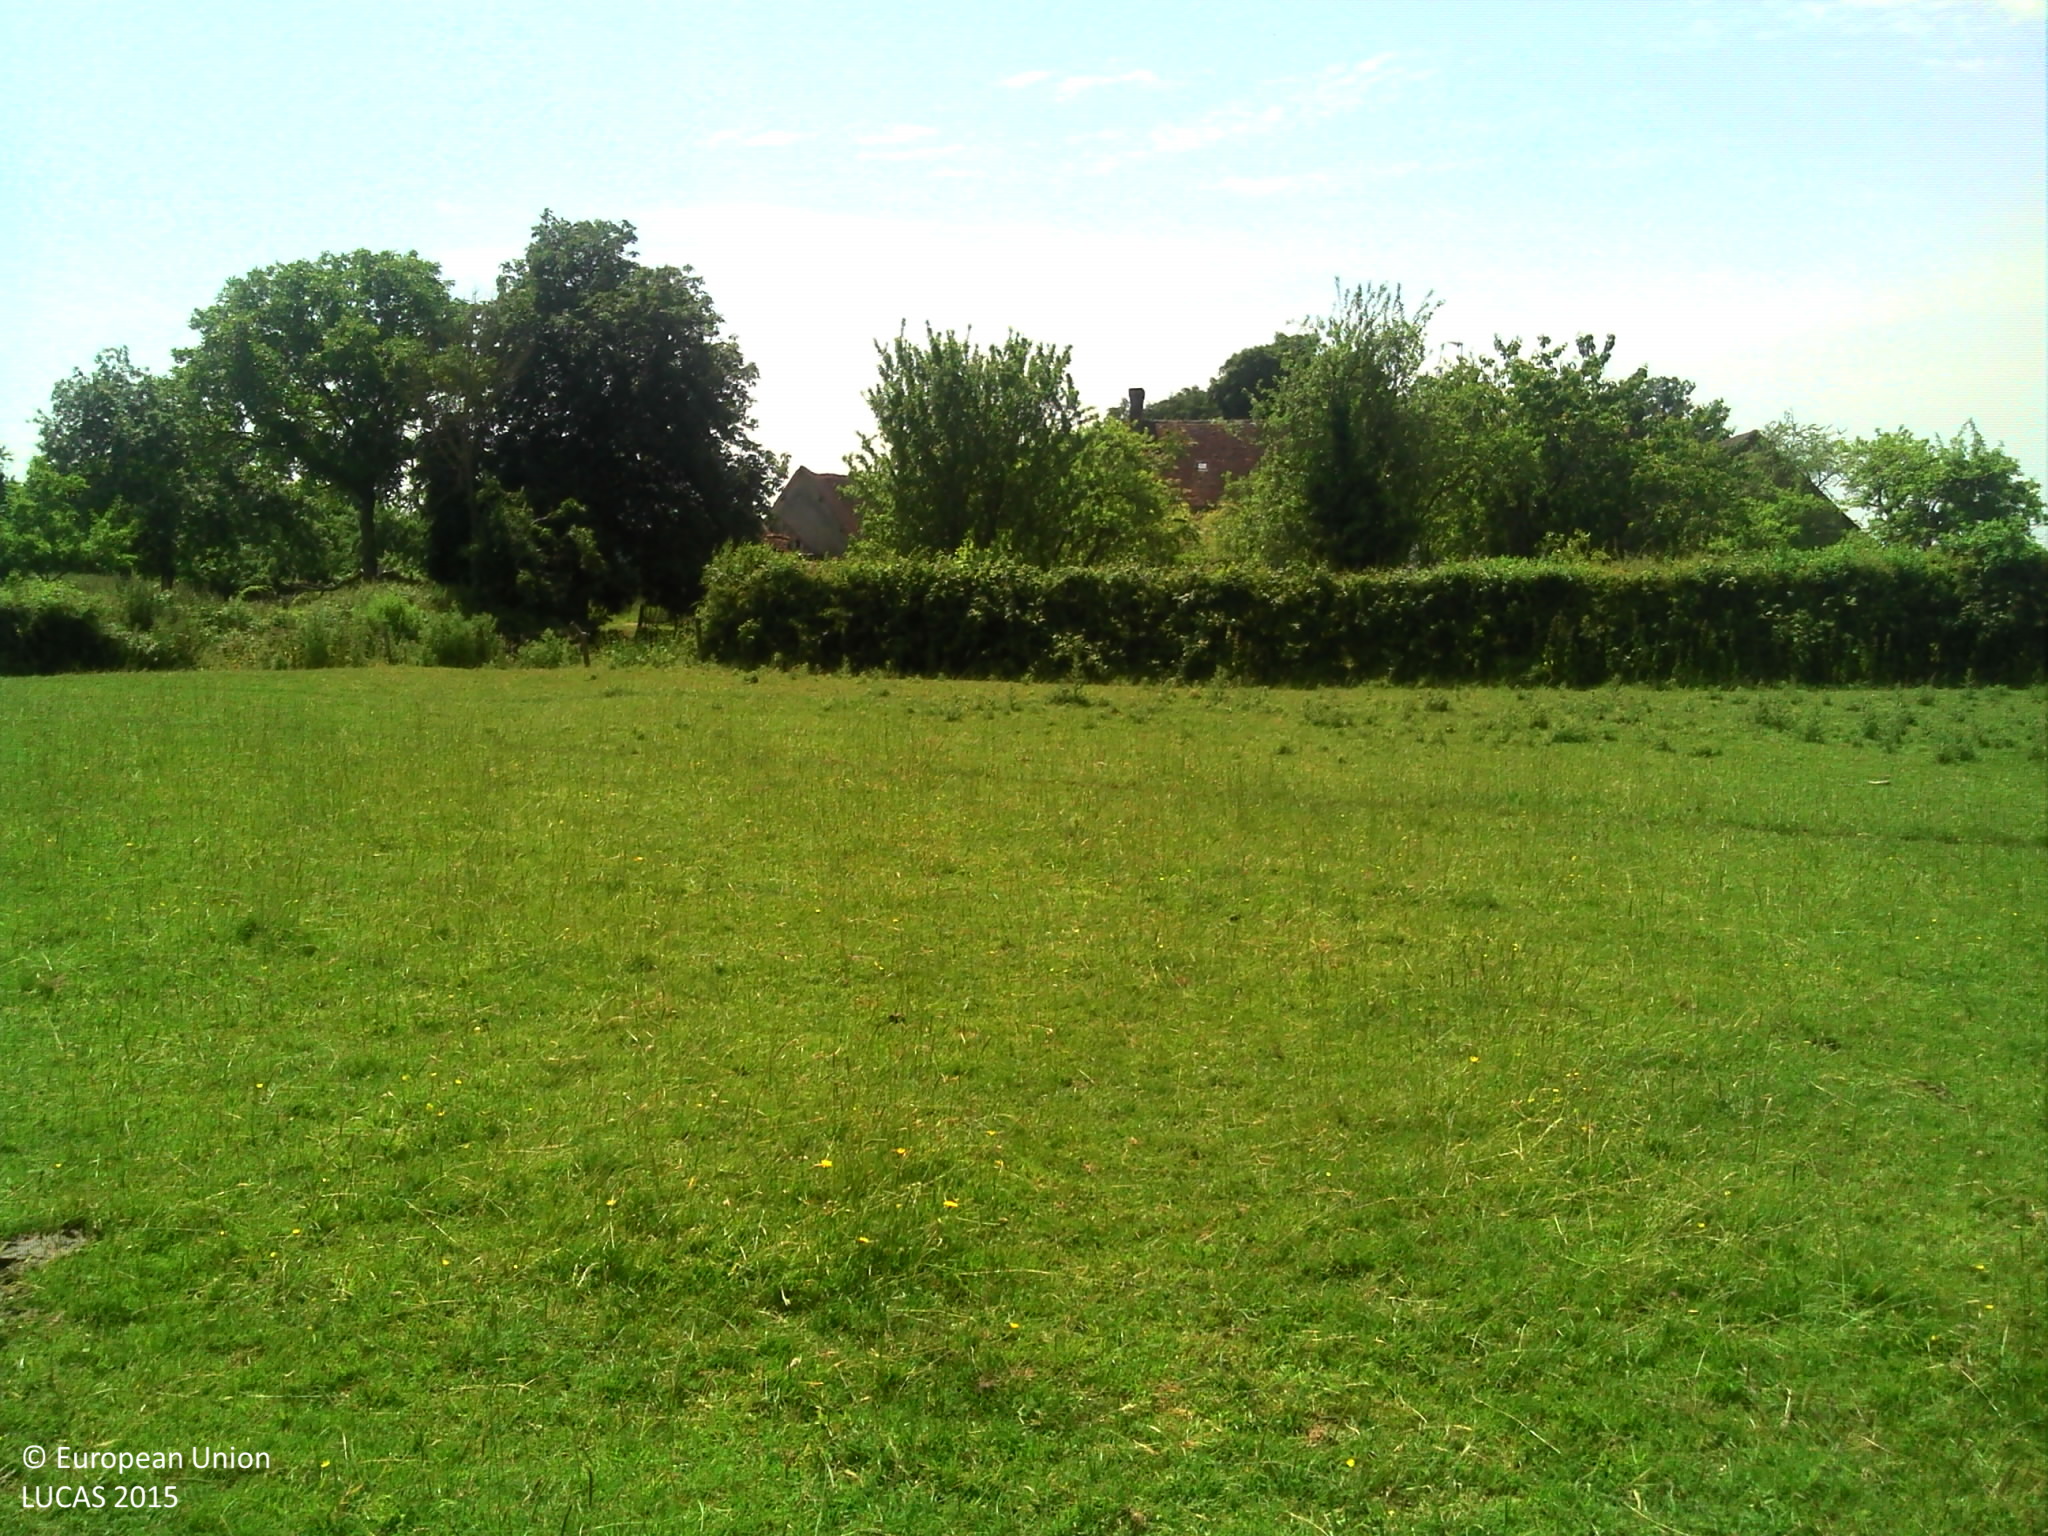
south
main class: Grassland
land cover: Grassland without tree/shrub cover
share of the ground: > 75 %
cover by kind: herbaceous plants 95 %
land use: Agriculture (excluding fallow land and kitchen gardens)
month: June
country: FR
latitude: 48.5096
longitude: 0.1855
